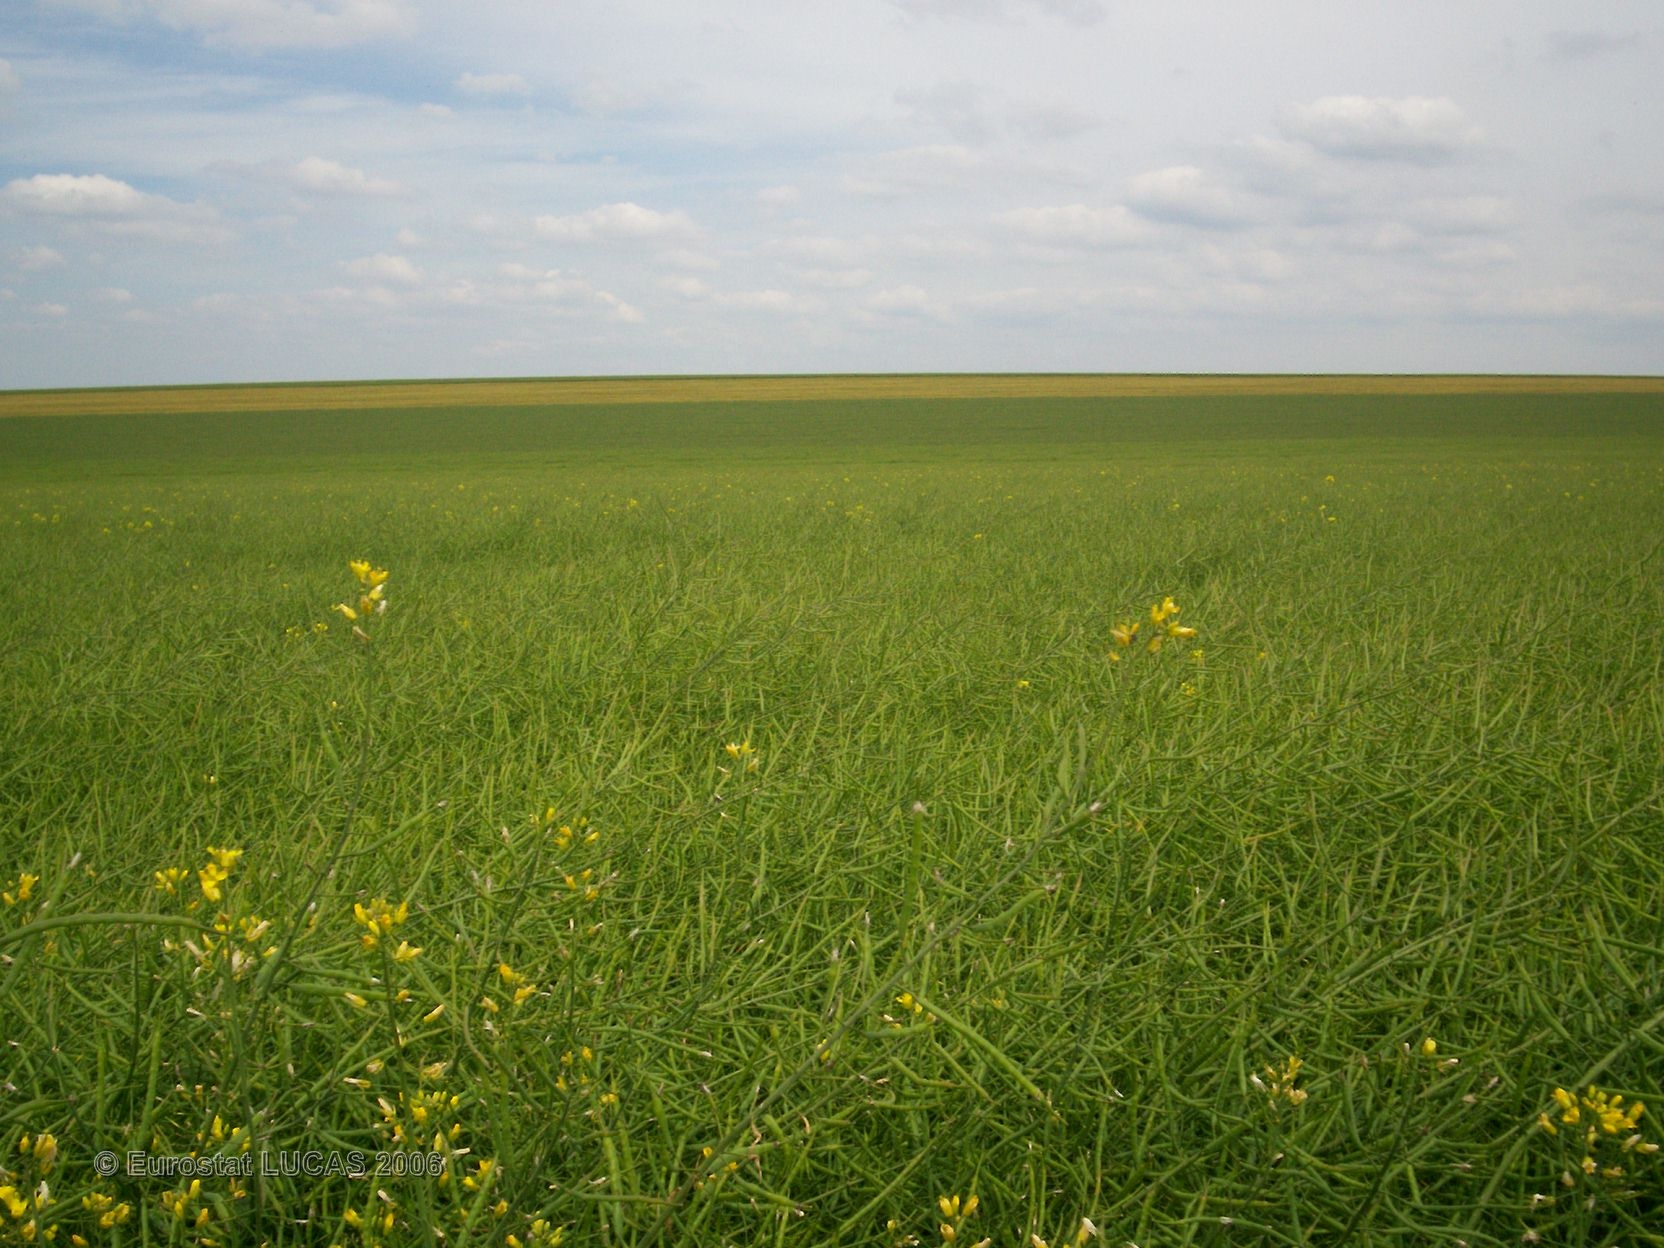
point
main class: Cropland
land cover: Rape and turnip rape
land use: Agriculture (excluding fallow land and kitchen gardens)
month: June
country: FR
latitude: 48.8851
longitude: 4.6103
